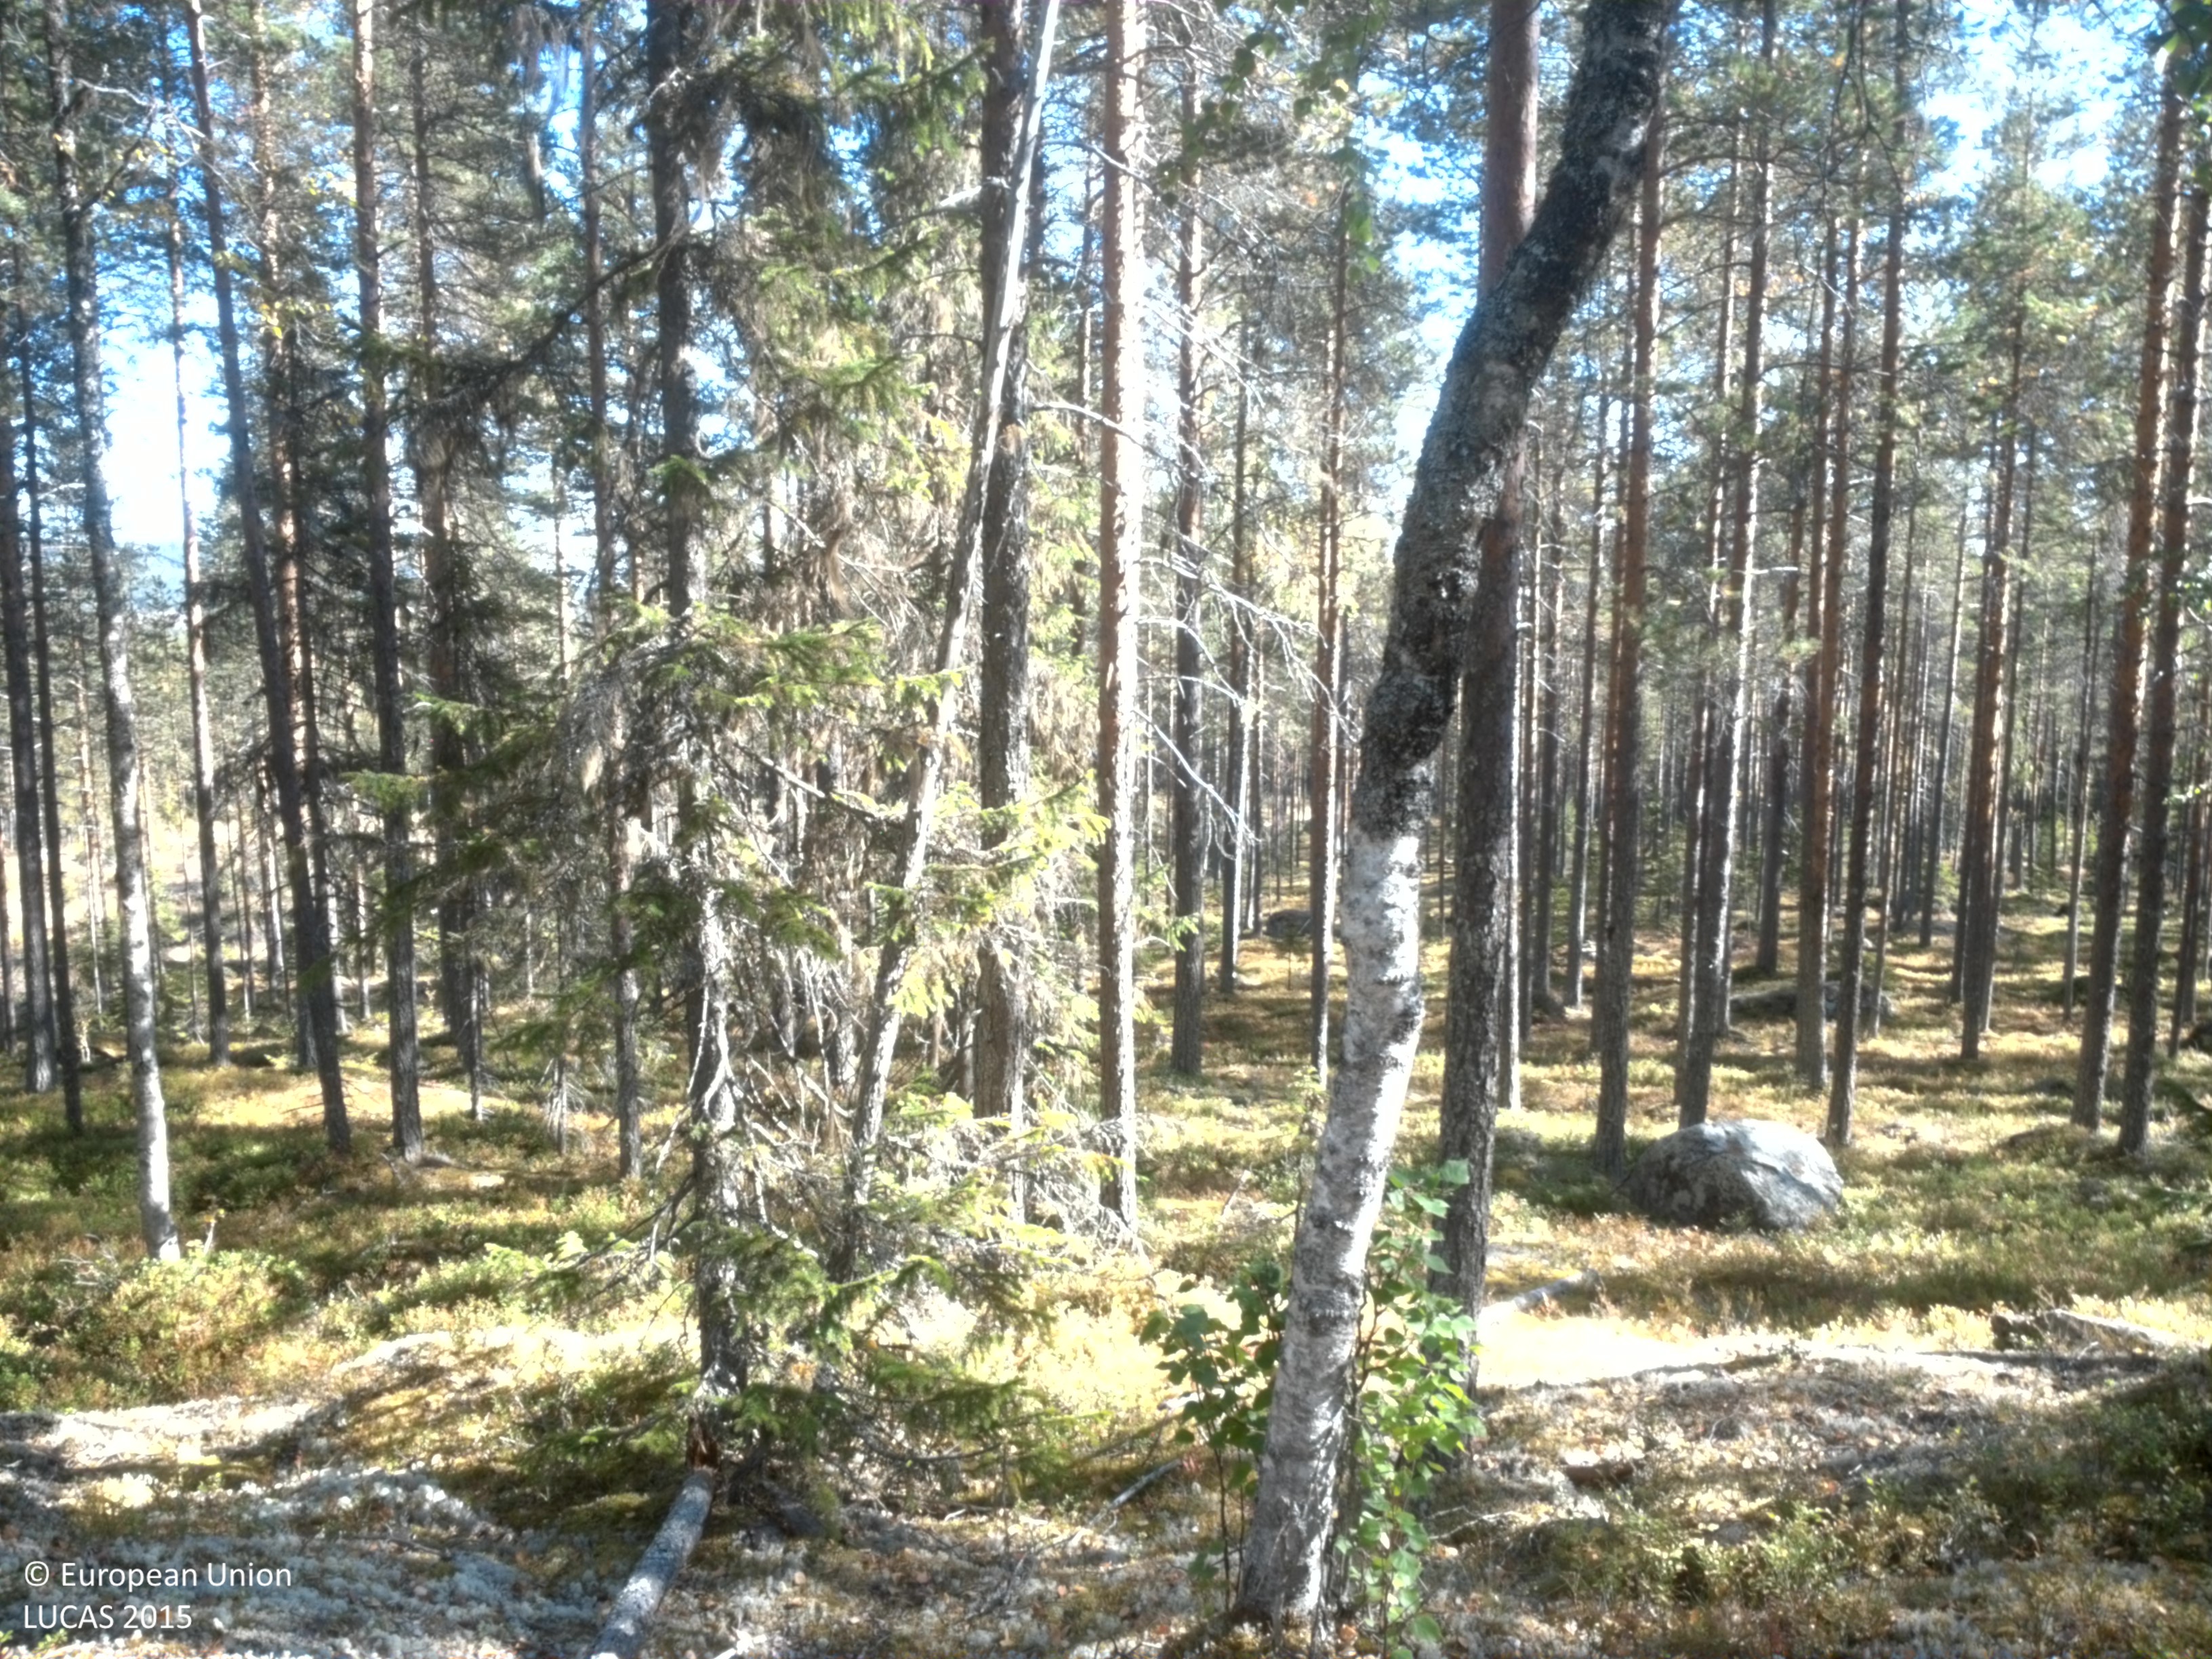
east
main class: Woodland
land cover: Pine dominated coniferous woodland
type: boreal forest
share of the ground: 50 - 75 %
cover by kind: coniferous forest trees 55 %, shrubs 35 %, lichens and mosses 5 %, consolidated bare surface 5 %
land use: Forestry
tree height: > 5 m
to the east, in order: Pine dominated coniferous woodland; Other coniferous woodland; Spruce dominated coniferous woodland; Pine dominated coniferous woodland; Other coniferous woodland
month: September
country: SE
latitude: 64.2470
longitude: 19.6906
